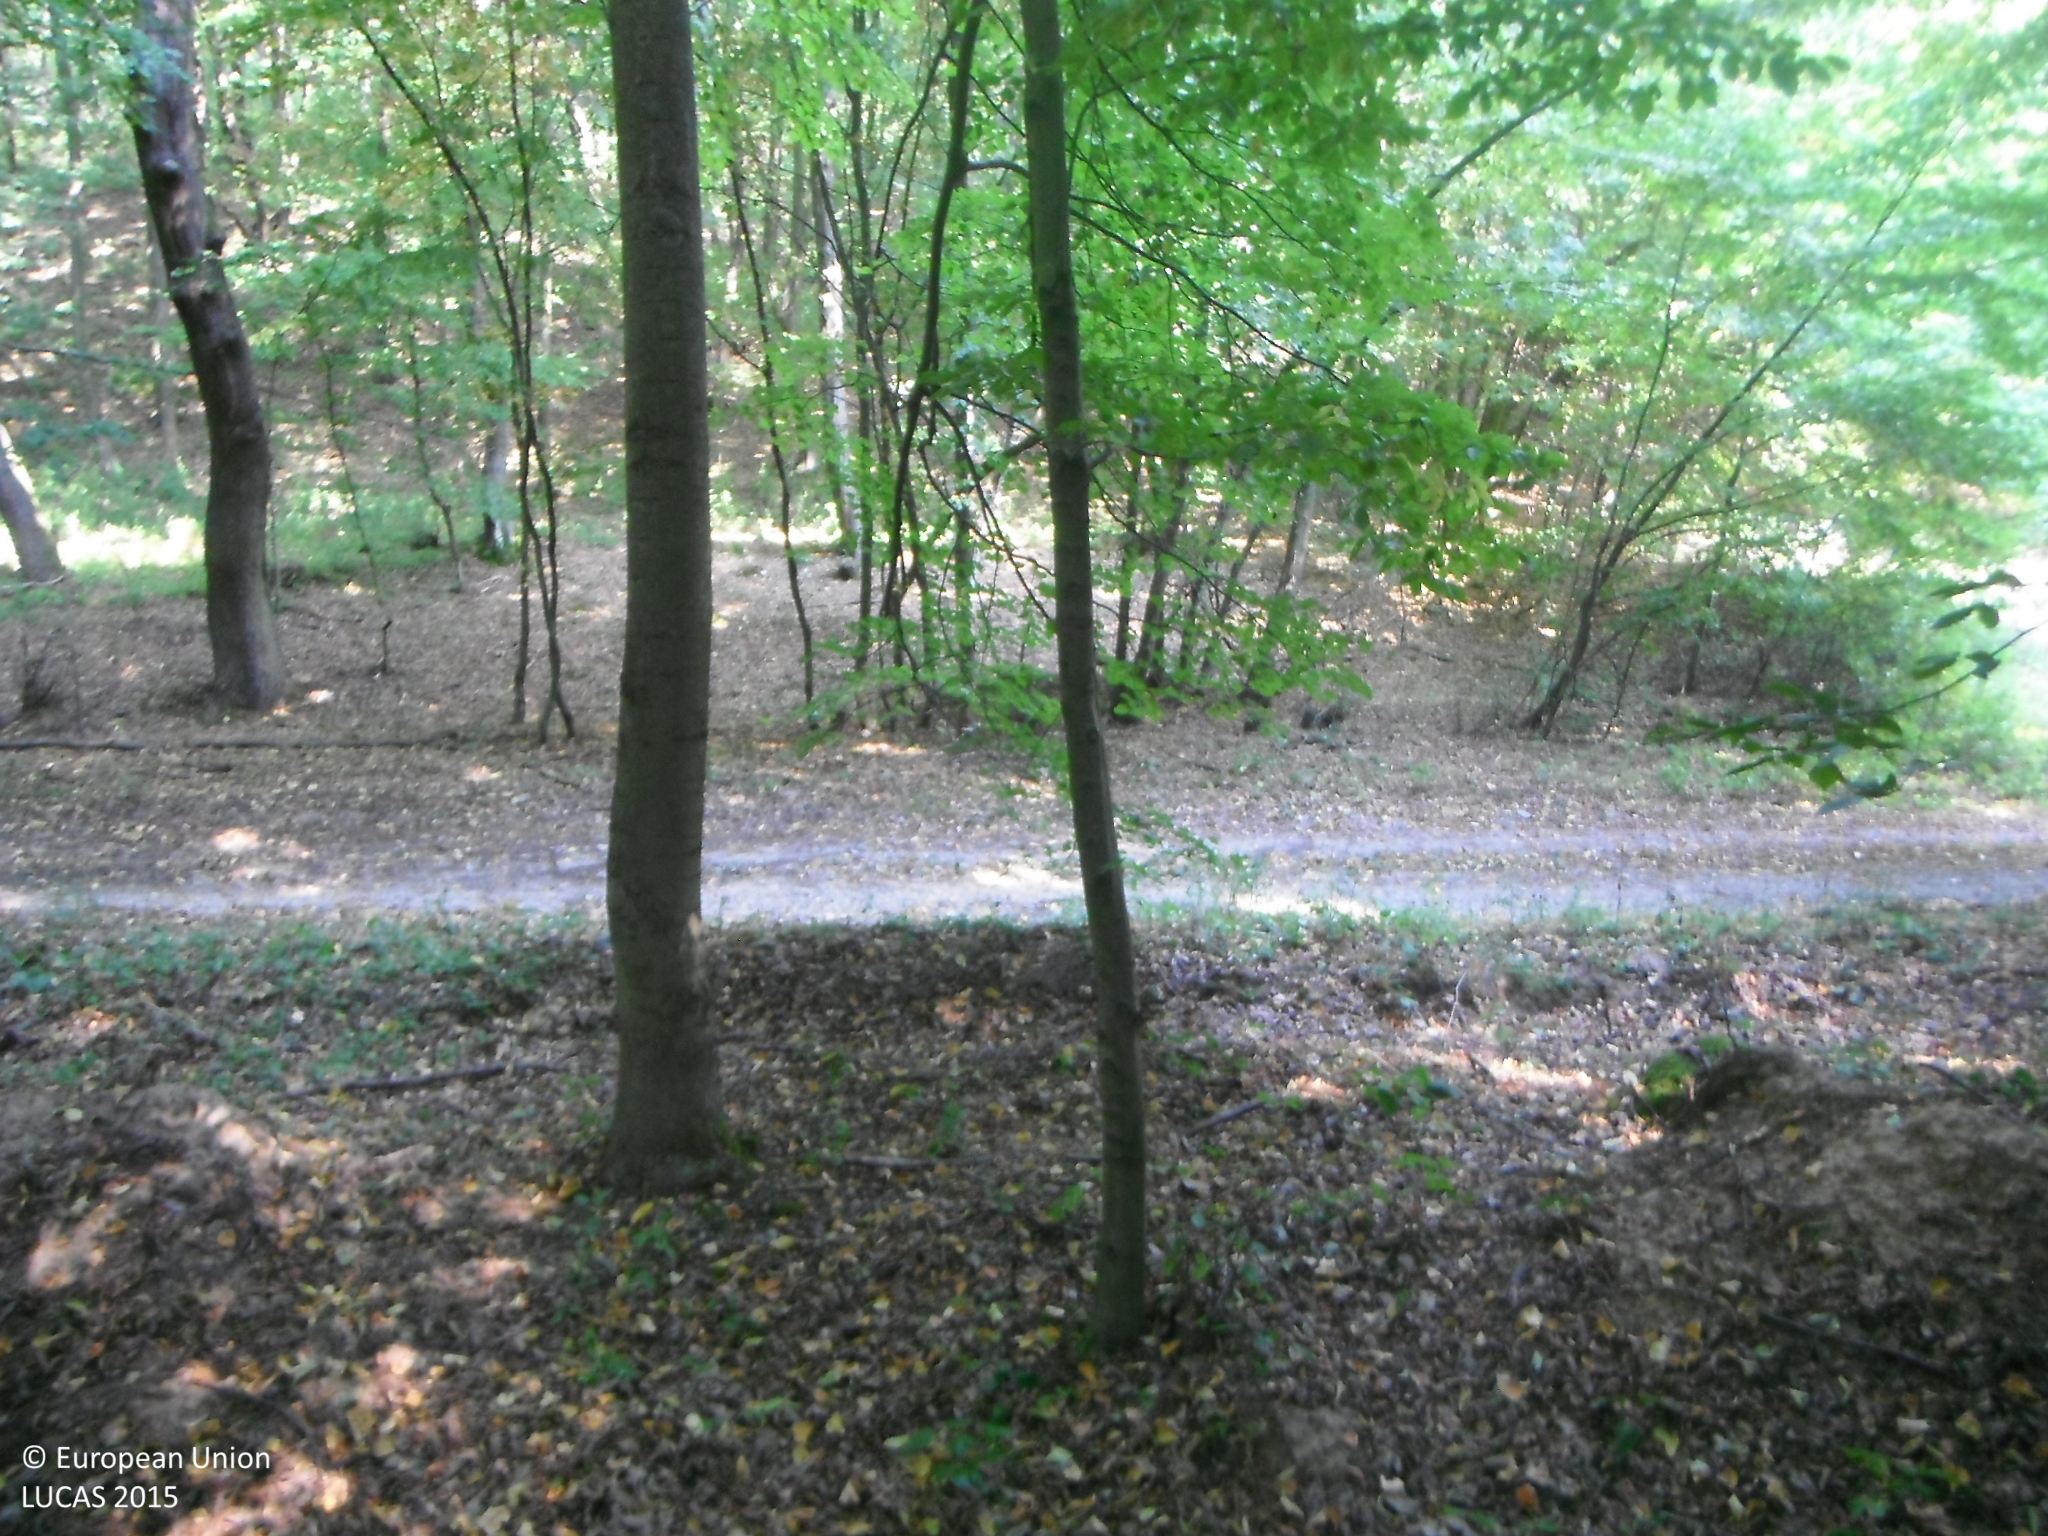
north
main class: Woodland
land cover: Broadleaved woodland
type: mesophytic deciduous forest
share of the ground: > 75 %
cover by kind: broadleaved forest trees 90 %, shrubs 5 %, unconsolidated bare surface 5 %
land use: Forestry
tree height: > 5 m
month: August
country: SK
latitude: 48.5934
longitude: 18.3546
